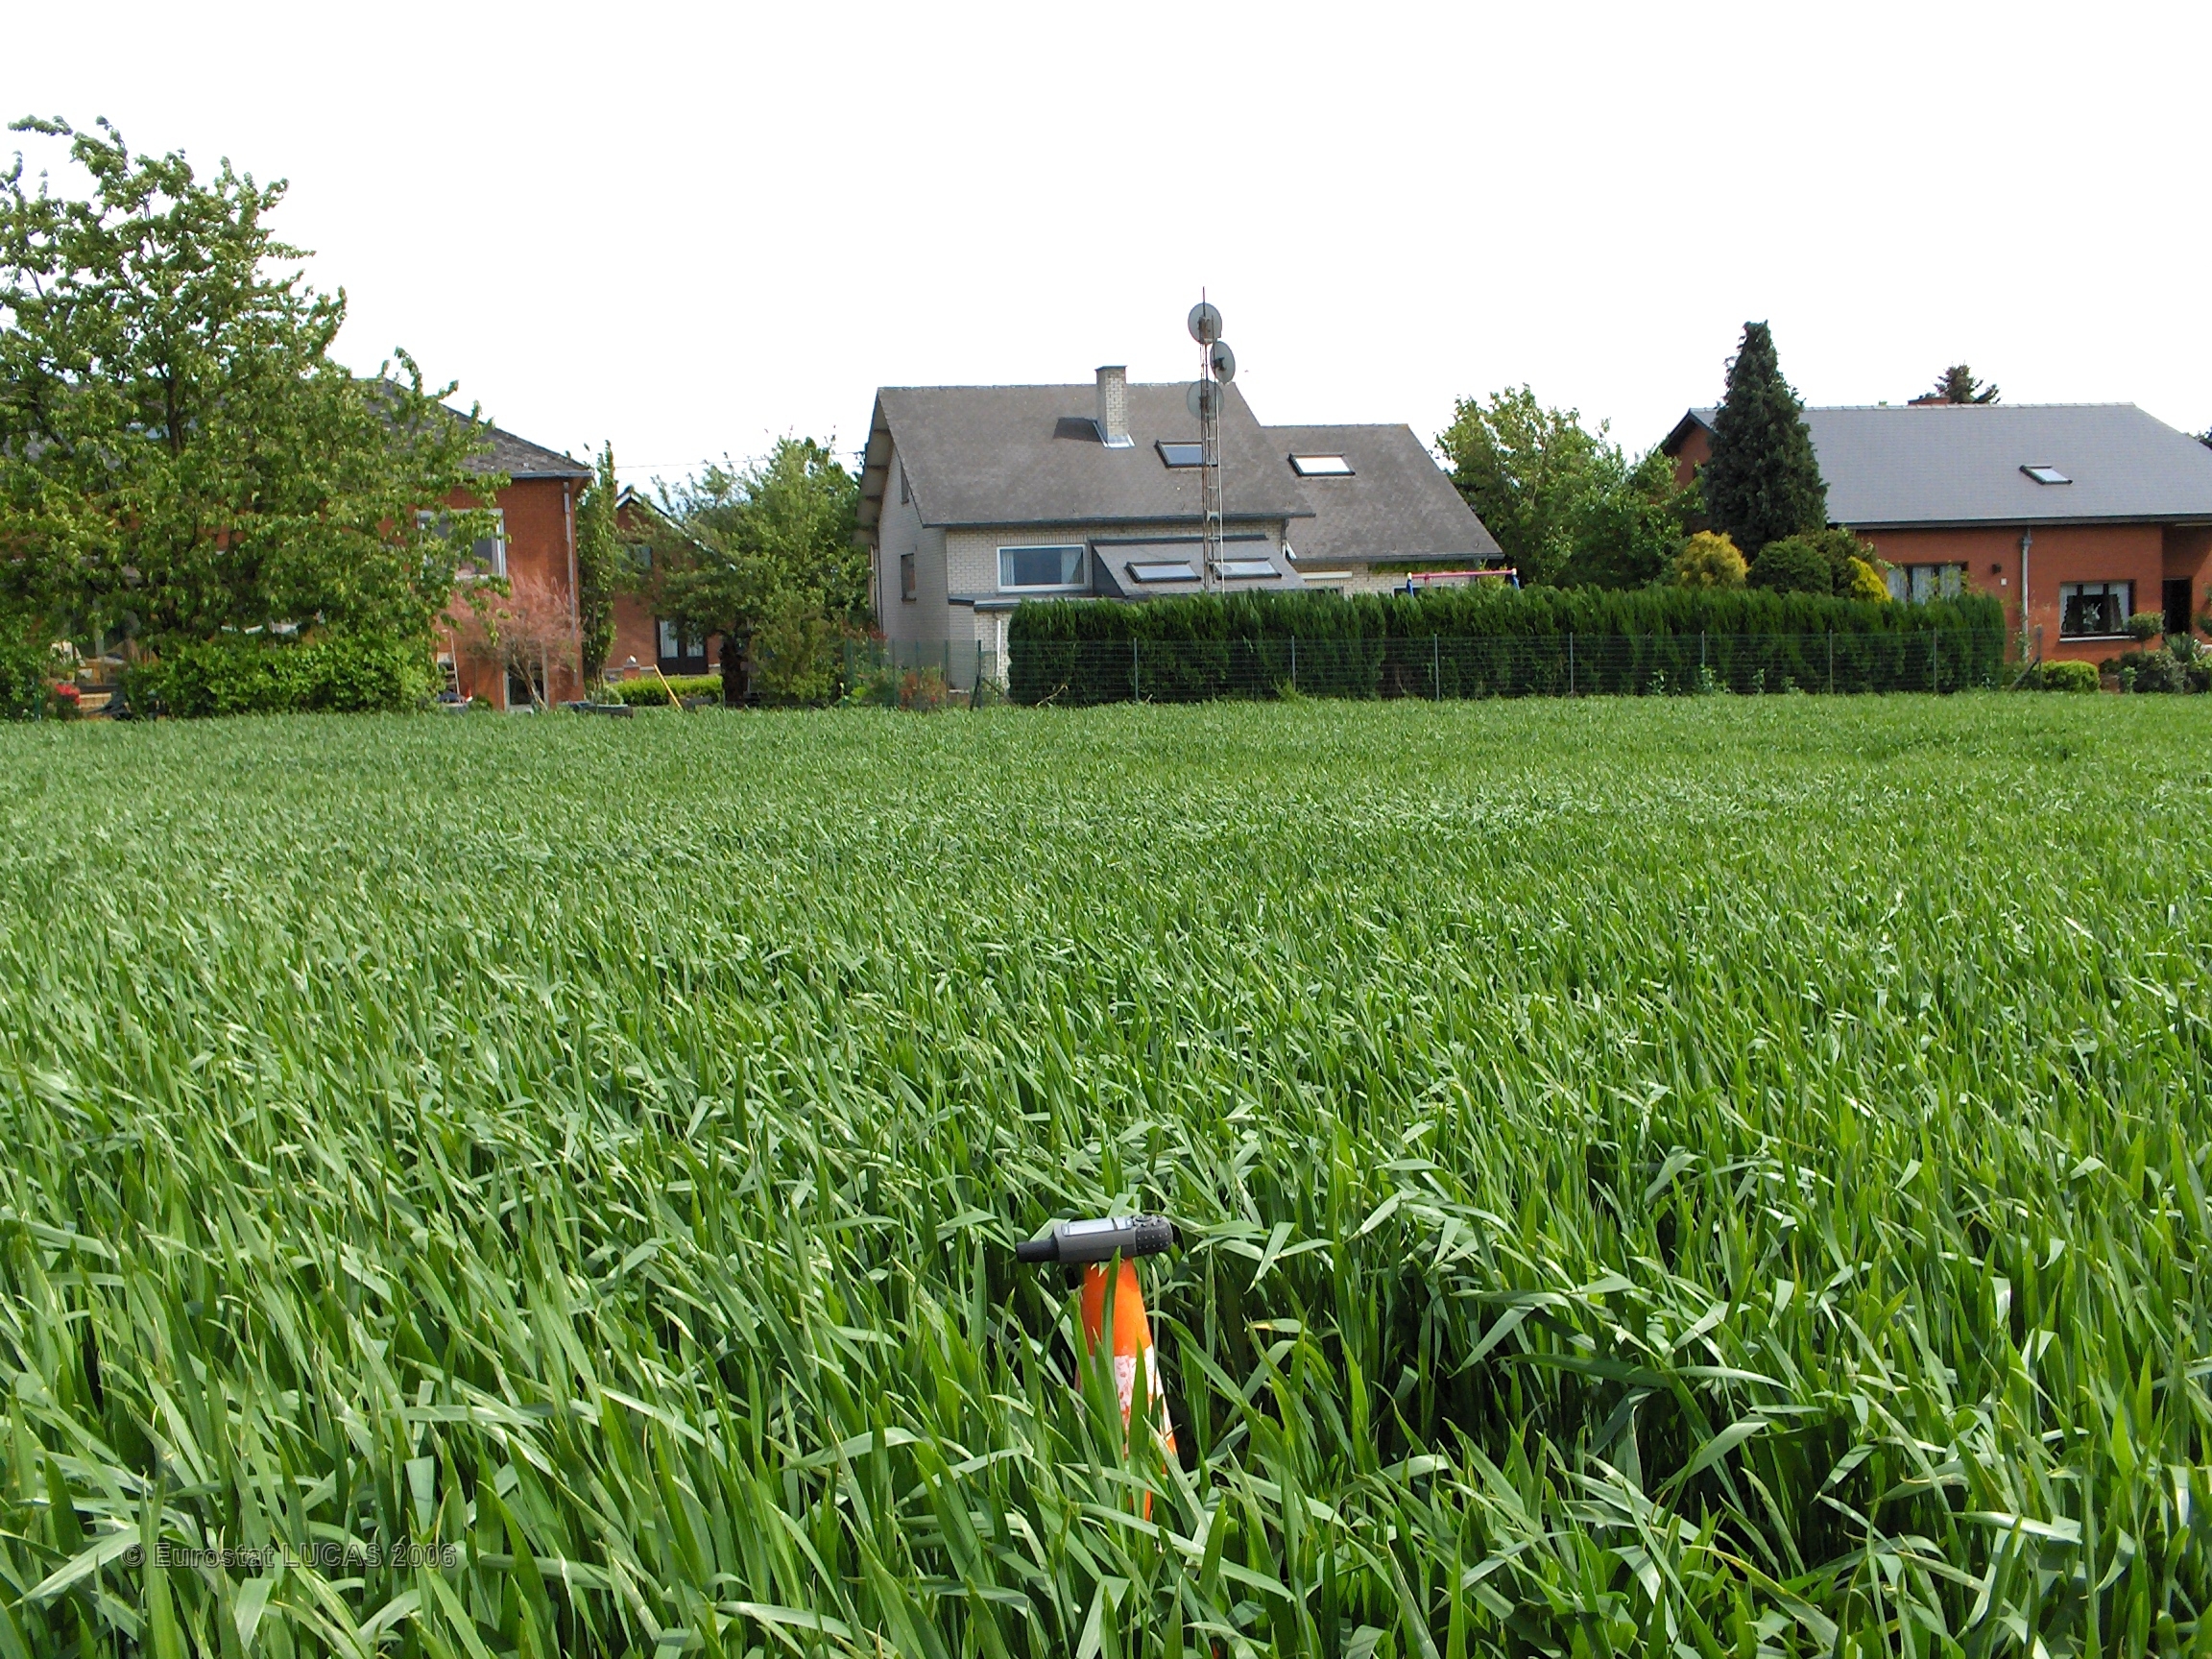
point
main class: Cropland
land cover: Common wheat
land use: Agriculture (excluding fallow land and kitchen gardens)
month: May
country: BE
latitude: 50.3606
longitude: 4.5560
